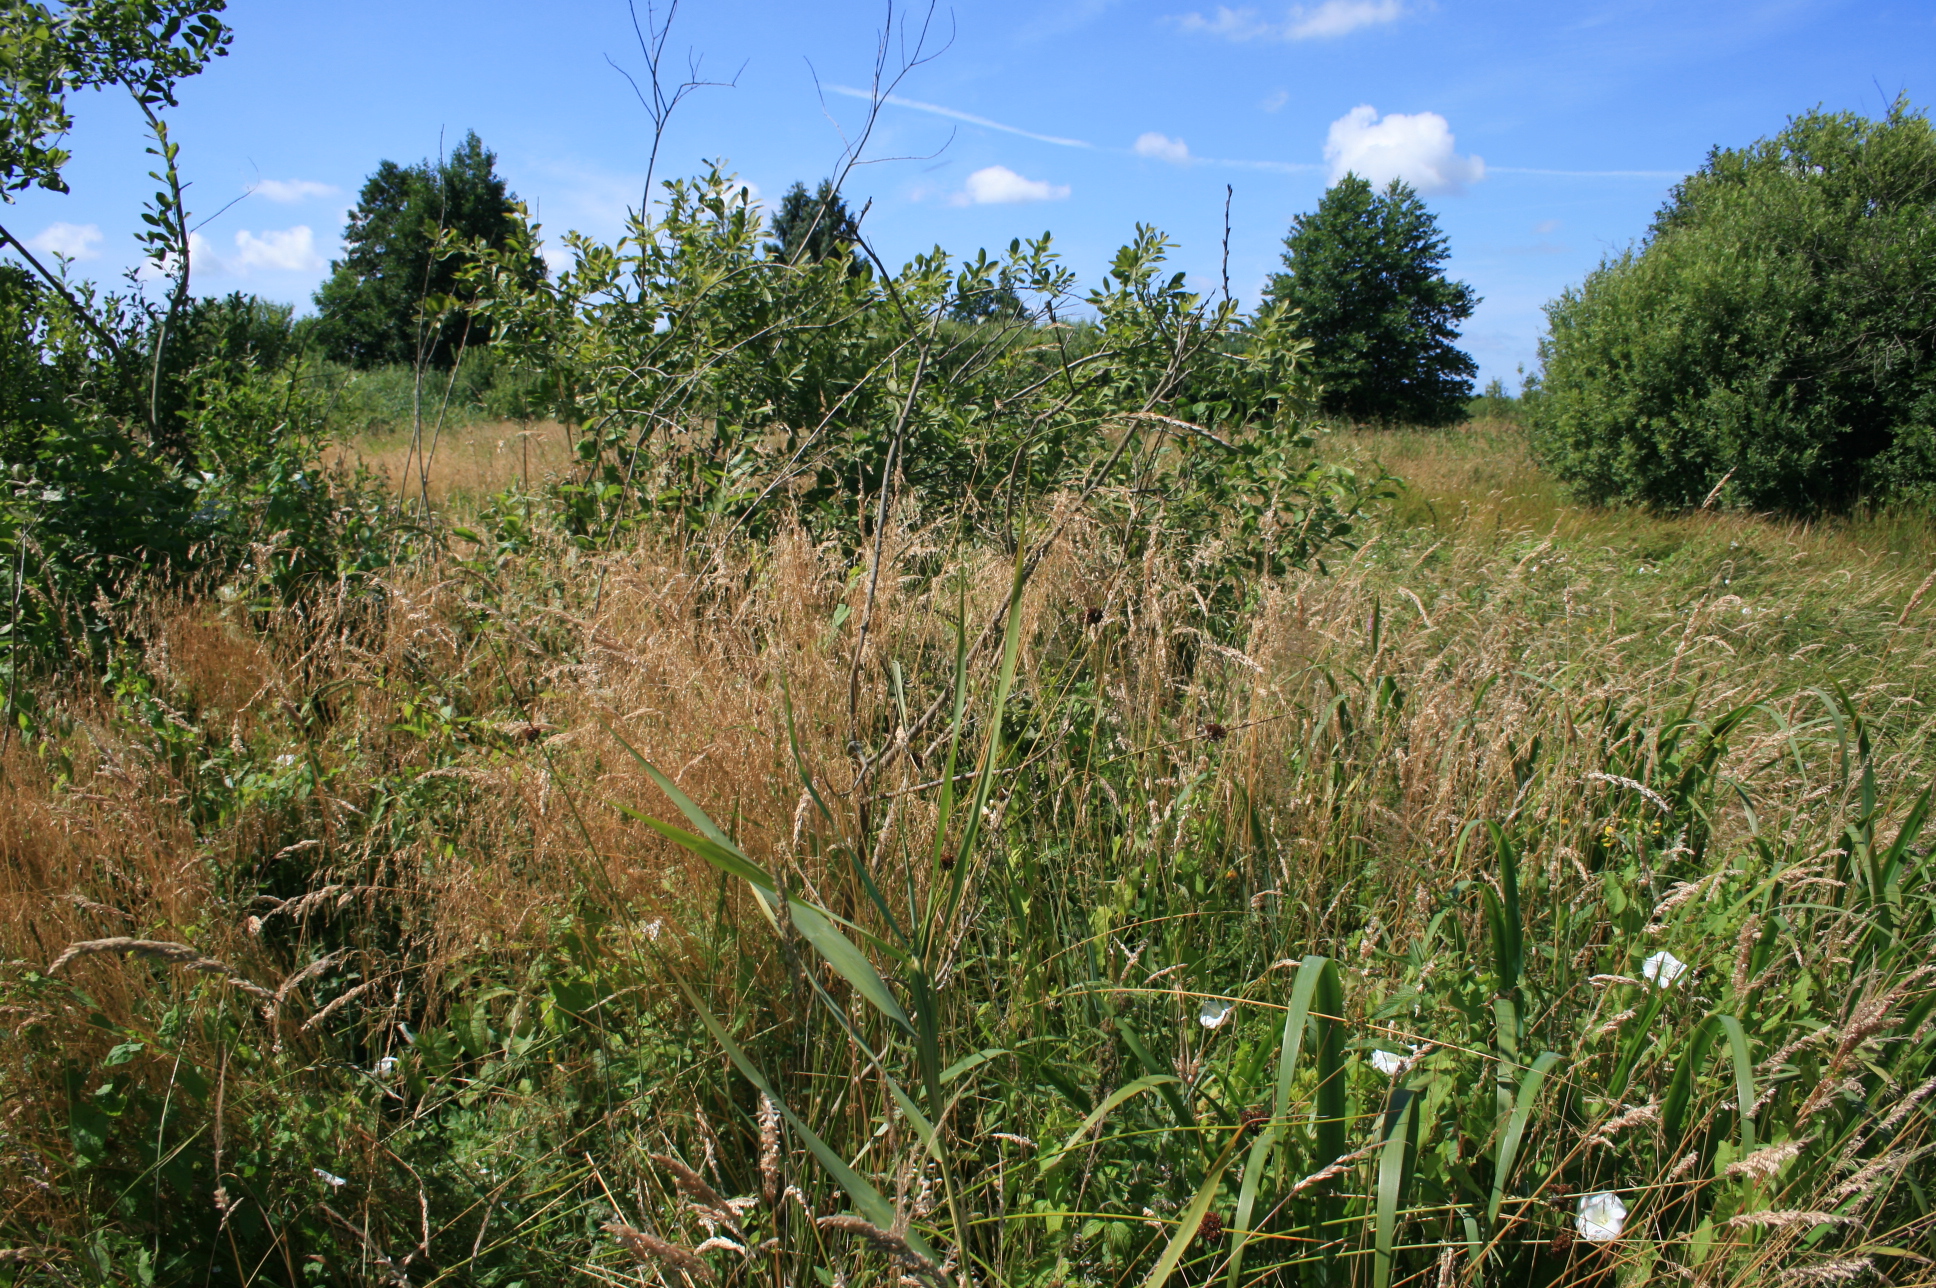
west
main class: Shrubland
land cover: Shrubland with sparse tree cover
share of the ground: 50 - 75 %
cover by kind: herbaceous plants 65 %, shrubs 30 %, broadleaved forest trees 5 %
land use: Semi-natural and natural areas not in use
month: July
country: LT
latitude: 55.4725
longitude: 21.2587
